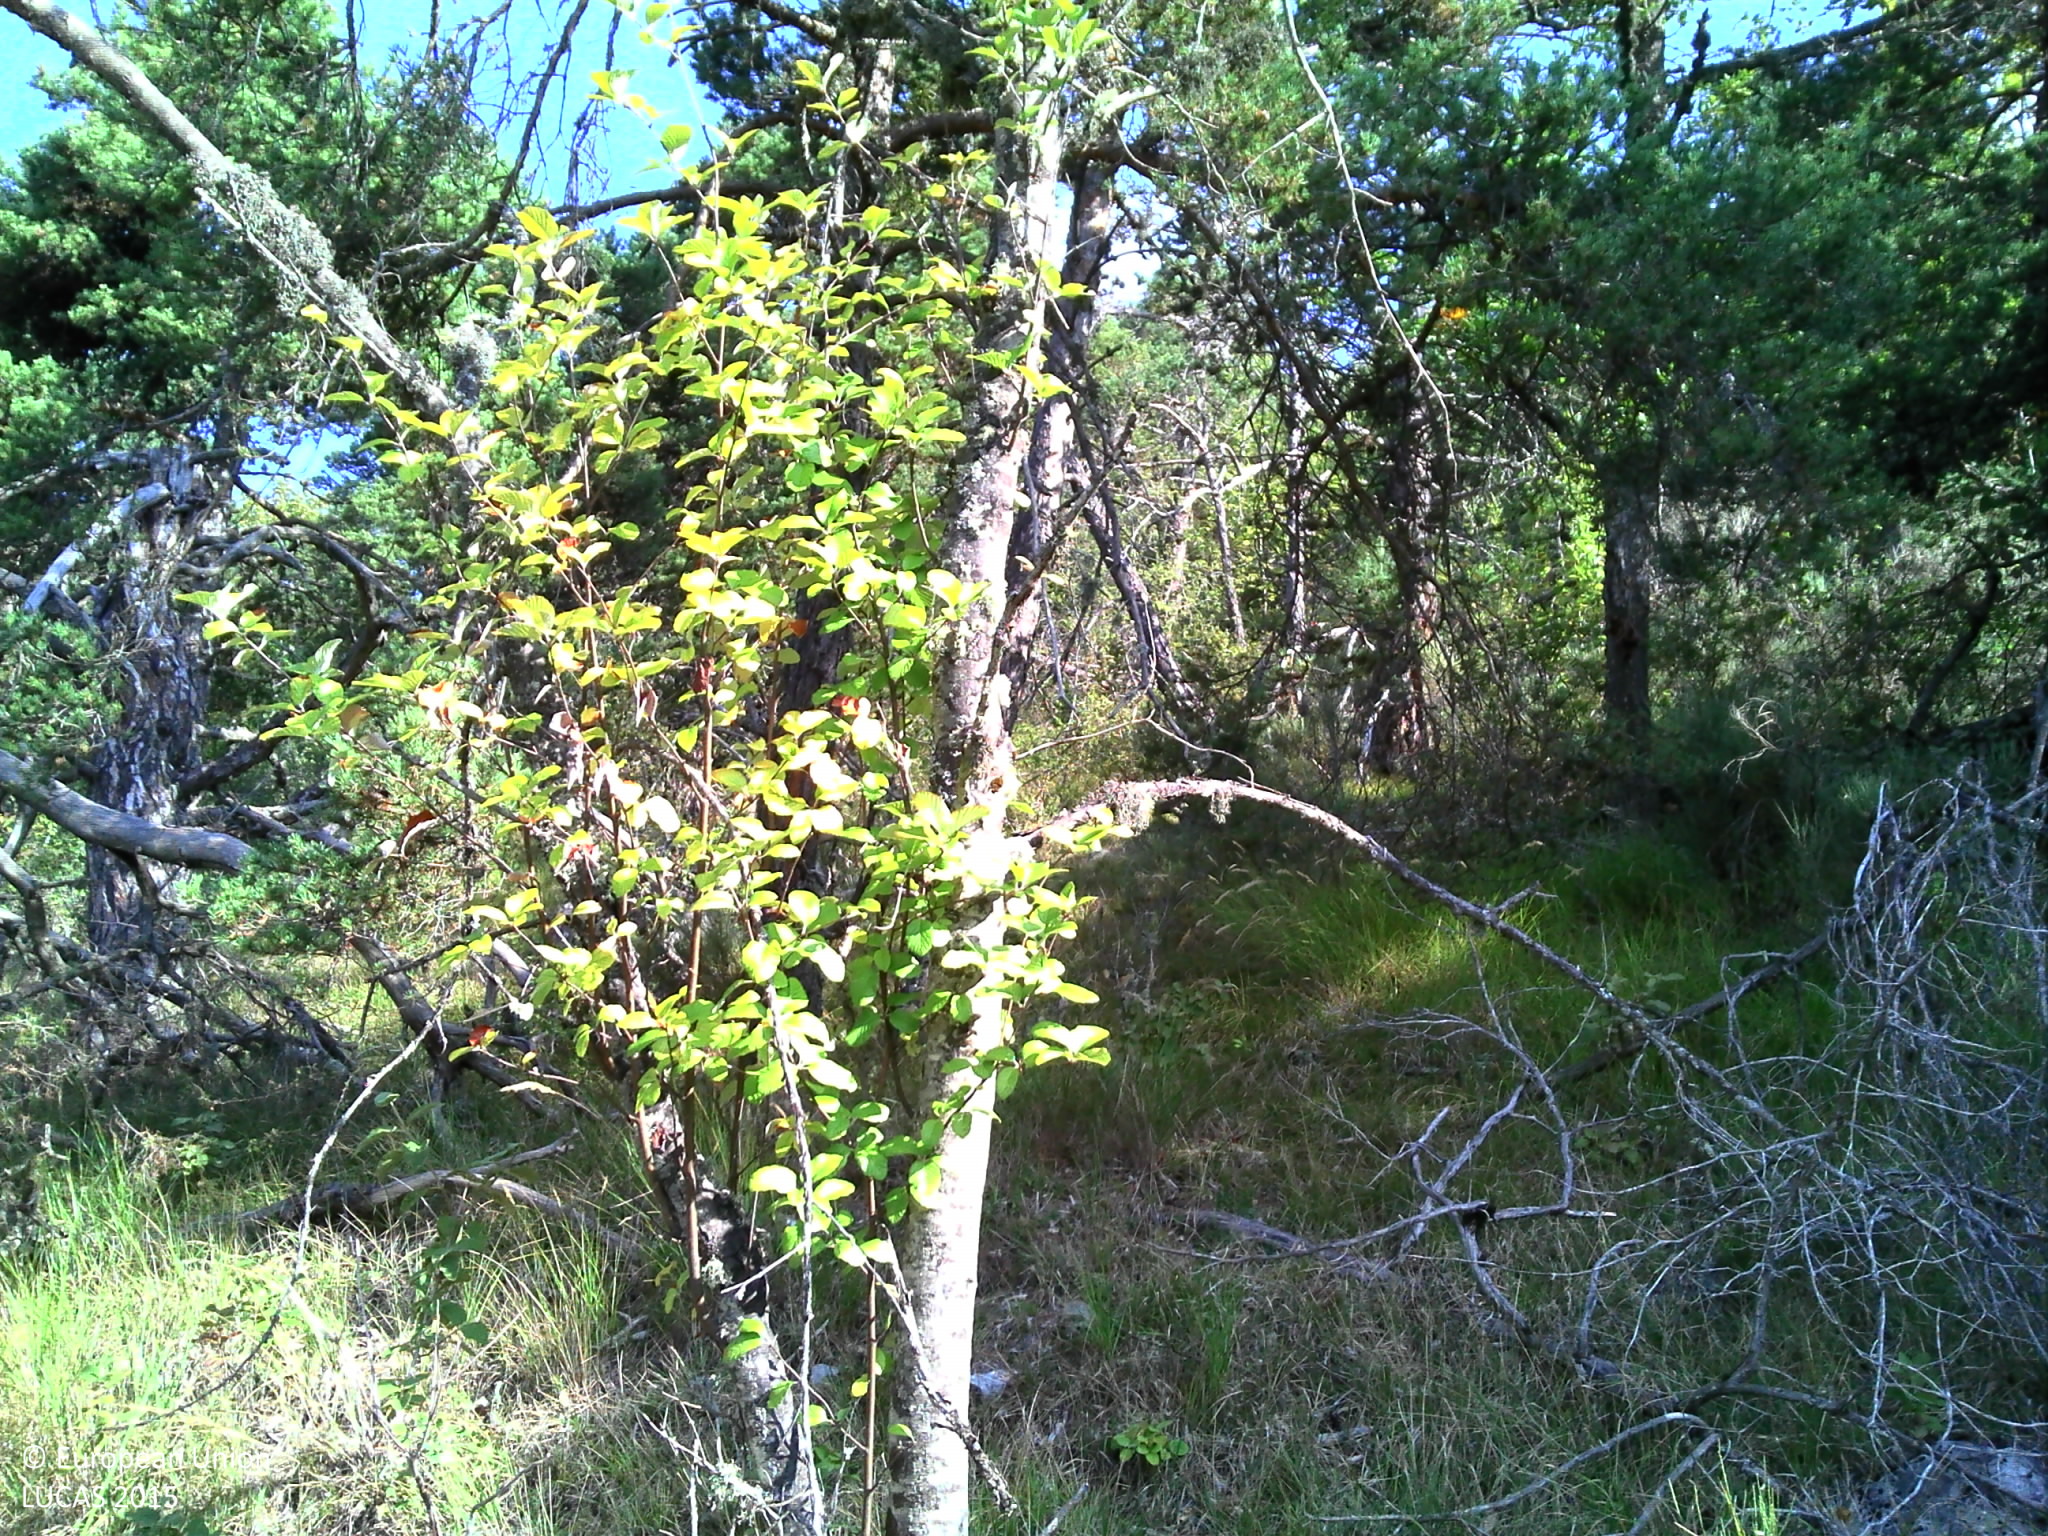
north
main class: Woodland
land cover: Pine dominated coniferous woodland
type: alpine coniferous forest
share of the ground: > 75 %
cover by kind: coniferous forest trees 50 %, herbaceous plants 20 %, broadleaved forest trees 10 %, shrubs 10 %, unconsolidated bare surface 10 %
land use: Semi-natural and natural areas not in use
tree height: > 5 m
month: September
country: FR
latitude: 44.4084
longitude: 6.2271
